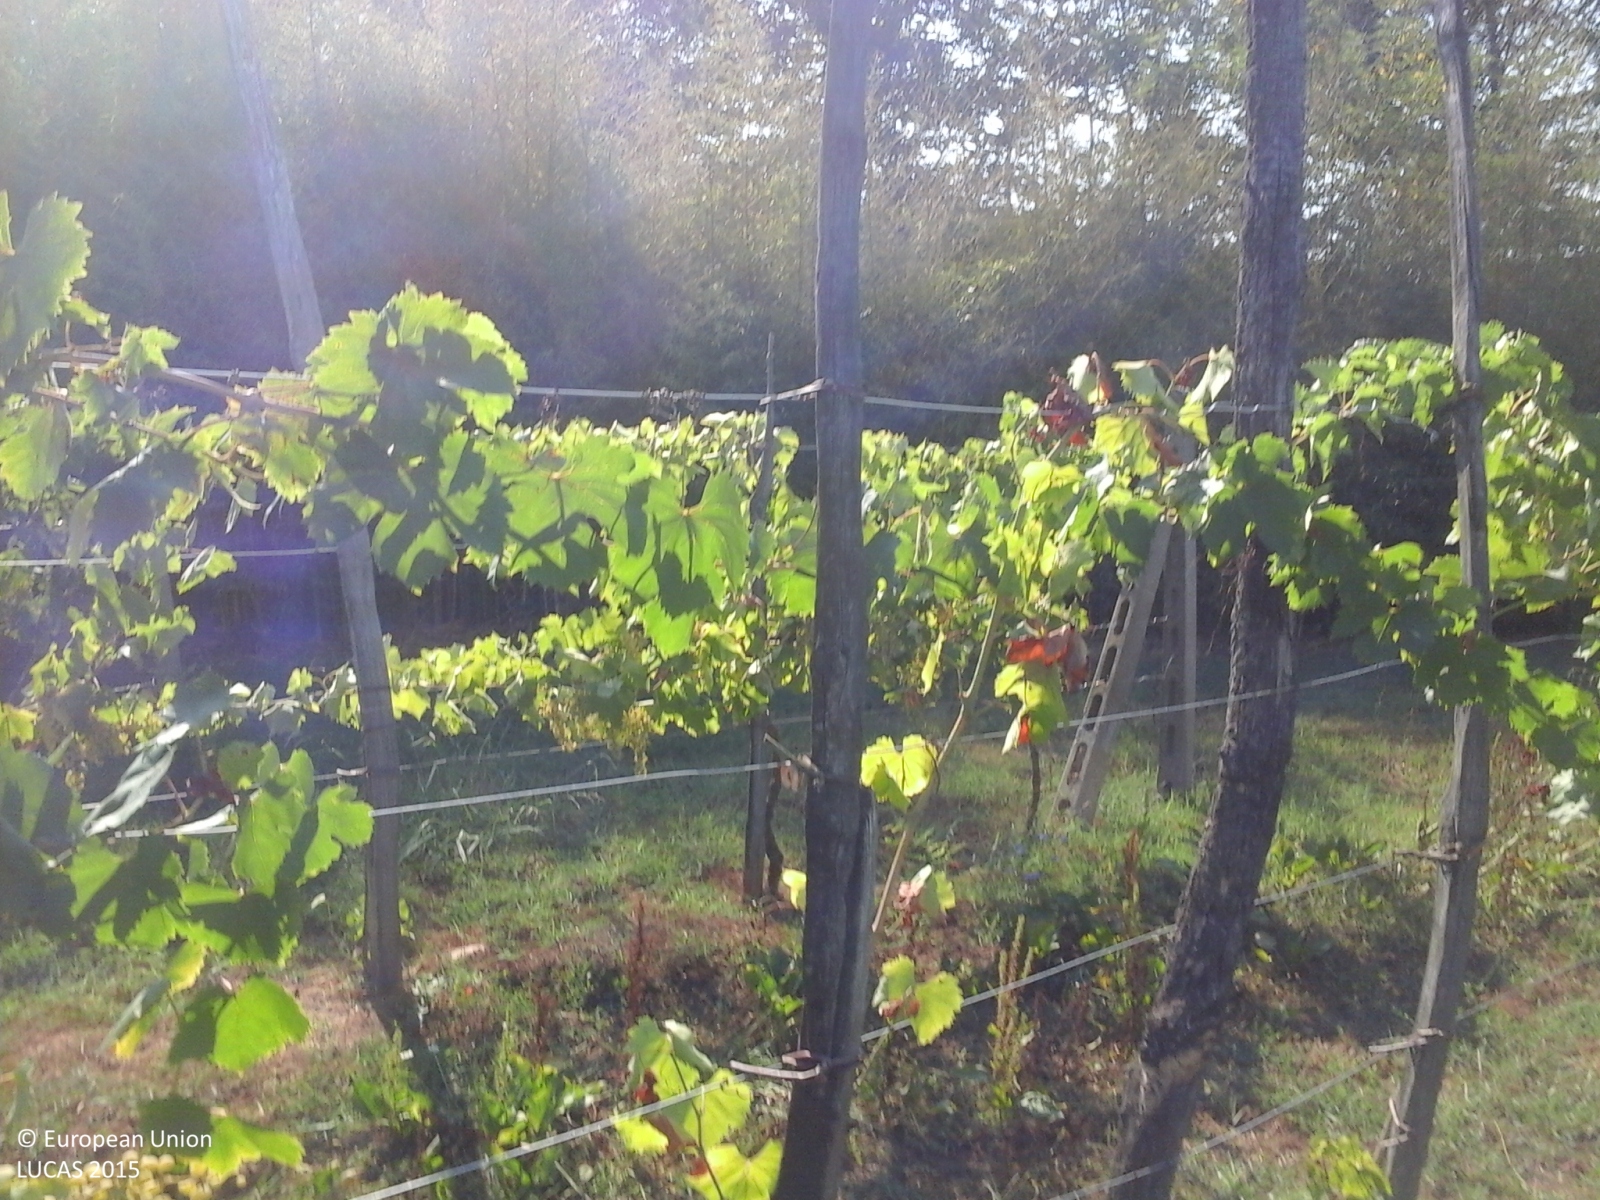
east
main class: Cropland
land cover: Vineyards
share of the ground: > 75 %
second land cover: Grassland without tree/shrub cover
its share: > 75 %
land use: Agriculture (excluding fallow land and kitchen gardens)
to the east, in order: Vineyards; Grassland without tree/shrub cover; Abandoned hedges; Inland fresh running water; Abandoned hedges; Grassland without tree/shrub cover; Ditches and canals; Grassland without tree/shrub cover; Grass margins; Paved roads, cycling and walking lanes; Grassland without tree/shrub cover; Tracks; Broadleaved woodland; Grassland without tree/shrub cover
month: August
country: IT
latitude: 43.8435
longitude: 10.6327
